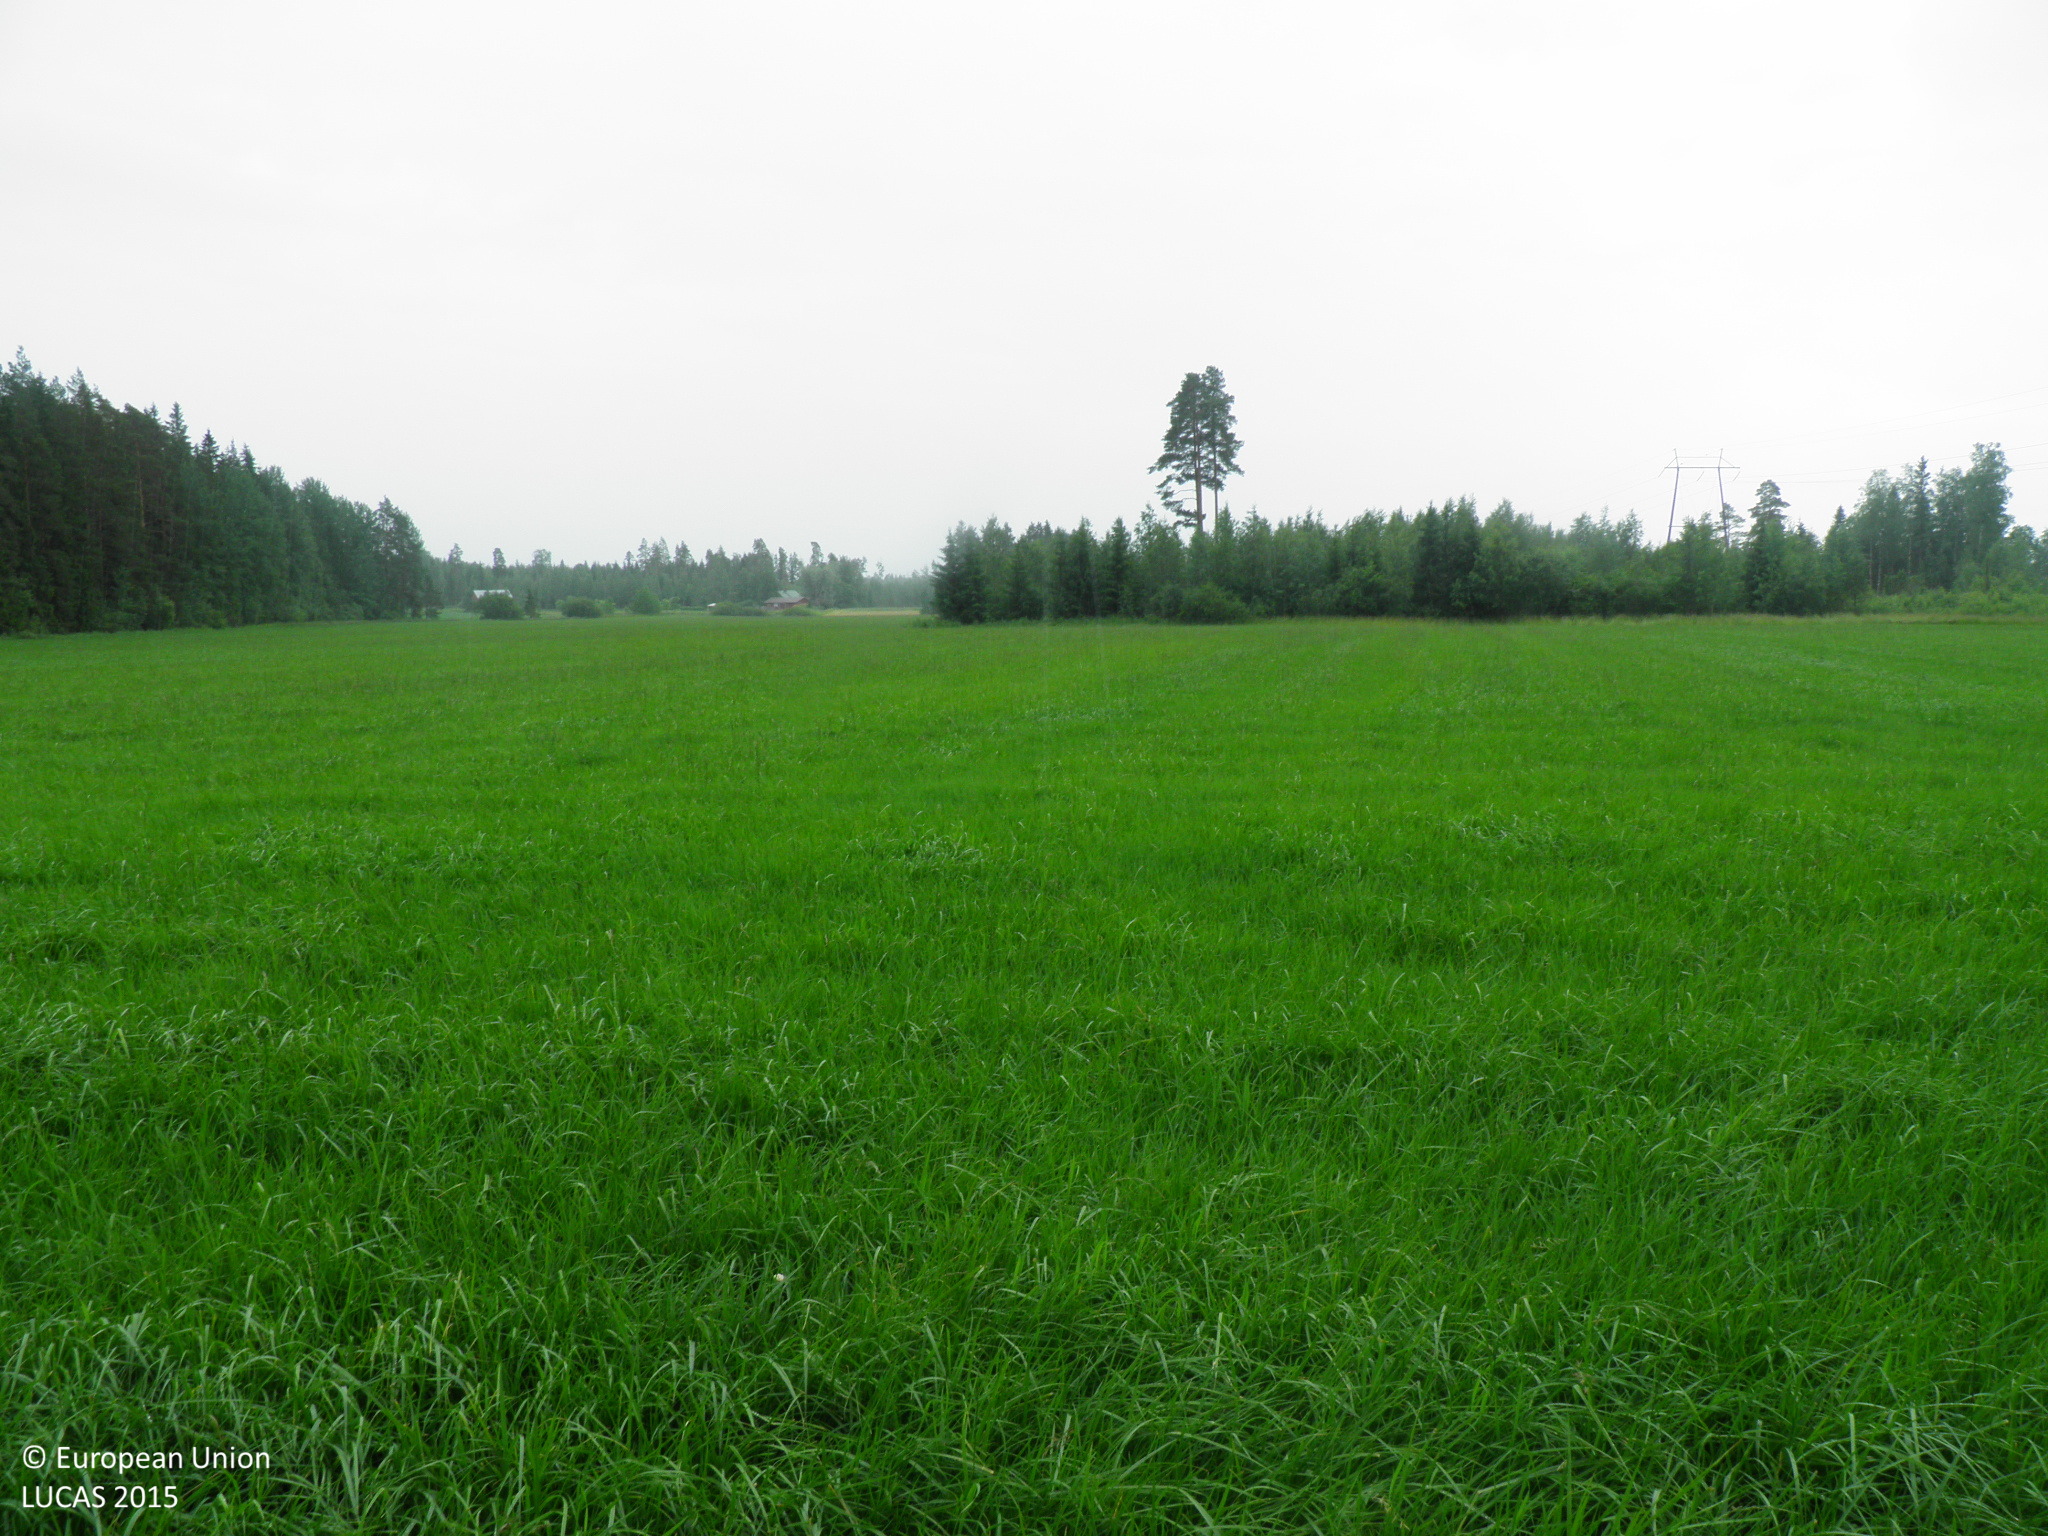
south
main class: Cropland
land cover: Temporary grasslands
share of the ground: > 75 %
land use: Agriculture (excluding fallow land and kitchen gardens)
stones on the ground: < 10 %
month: July
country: FI
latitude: 60.6556
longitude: 22.7874
